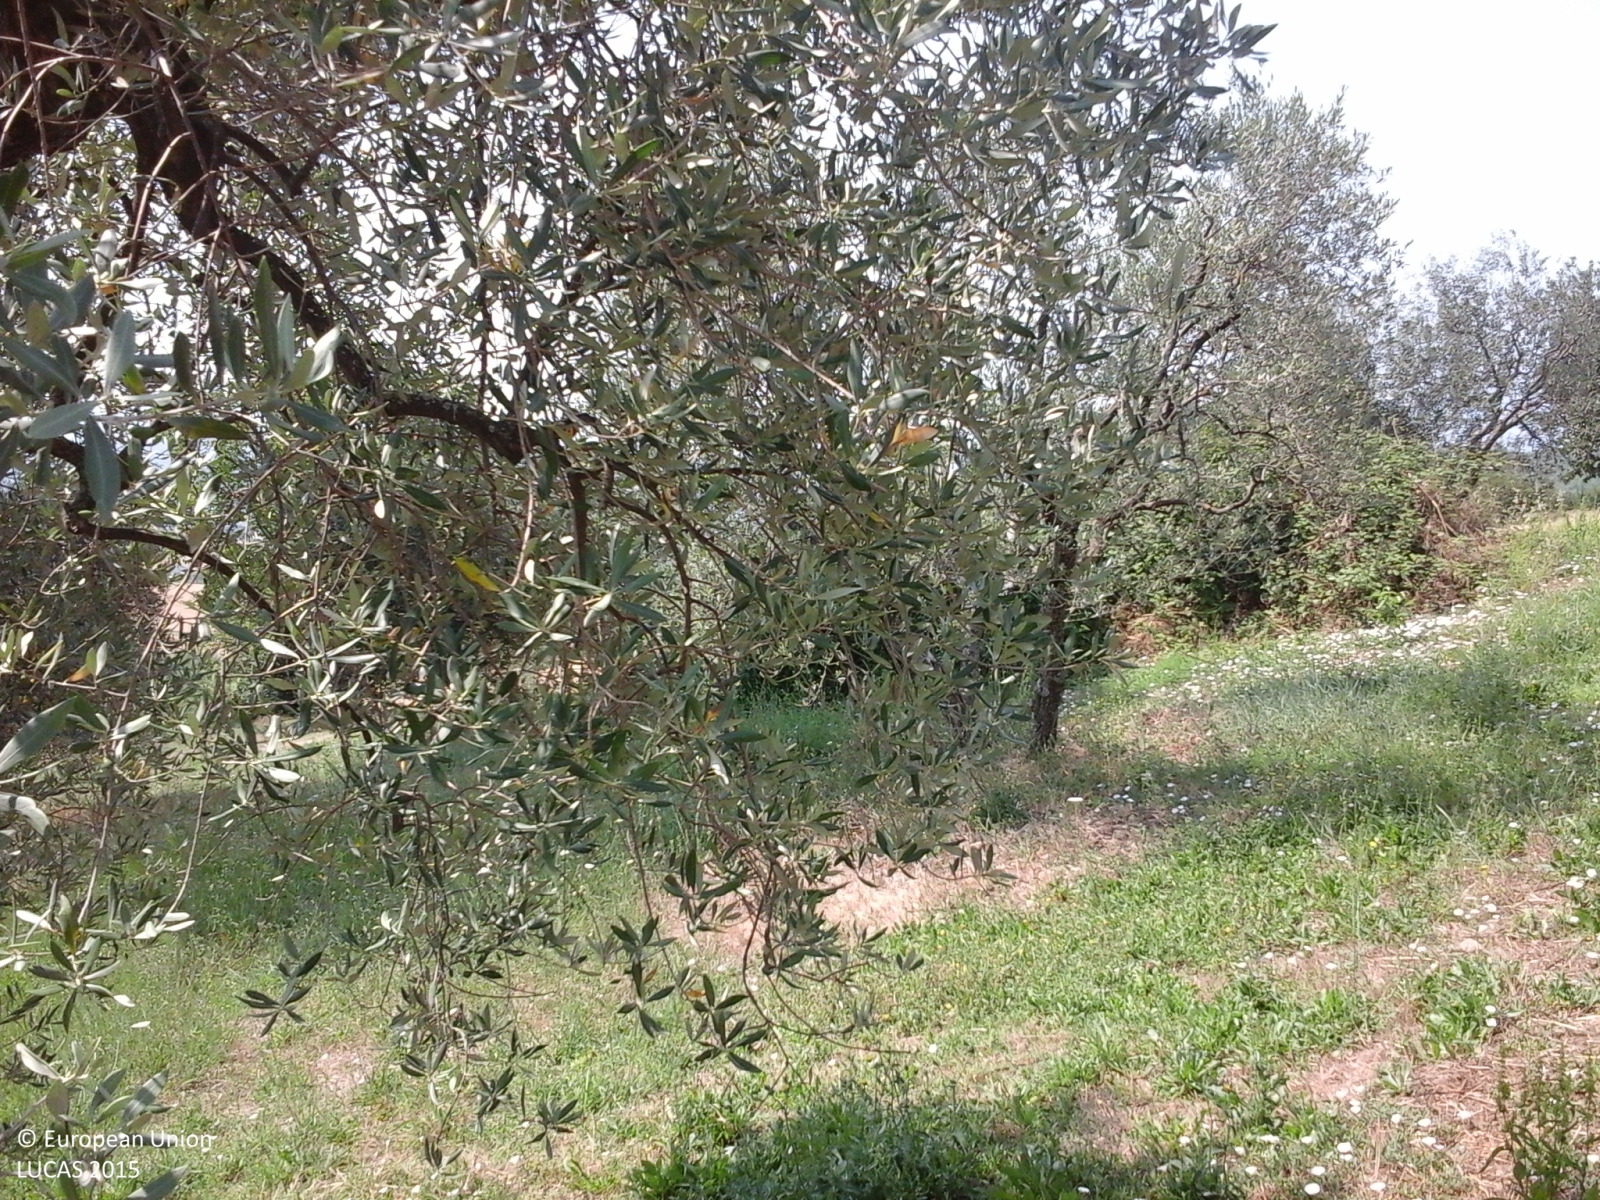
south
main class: Cropland
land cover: Olive groves
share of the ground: > 75 %
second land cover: Spontaneously vegetated surfaces
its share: > 75 %
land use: Agriculture (excluding fallow land and kitchen gardens)
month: July
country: IT
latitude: 40.9864
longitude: 15.1035
